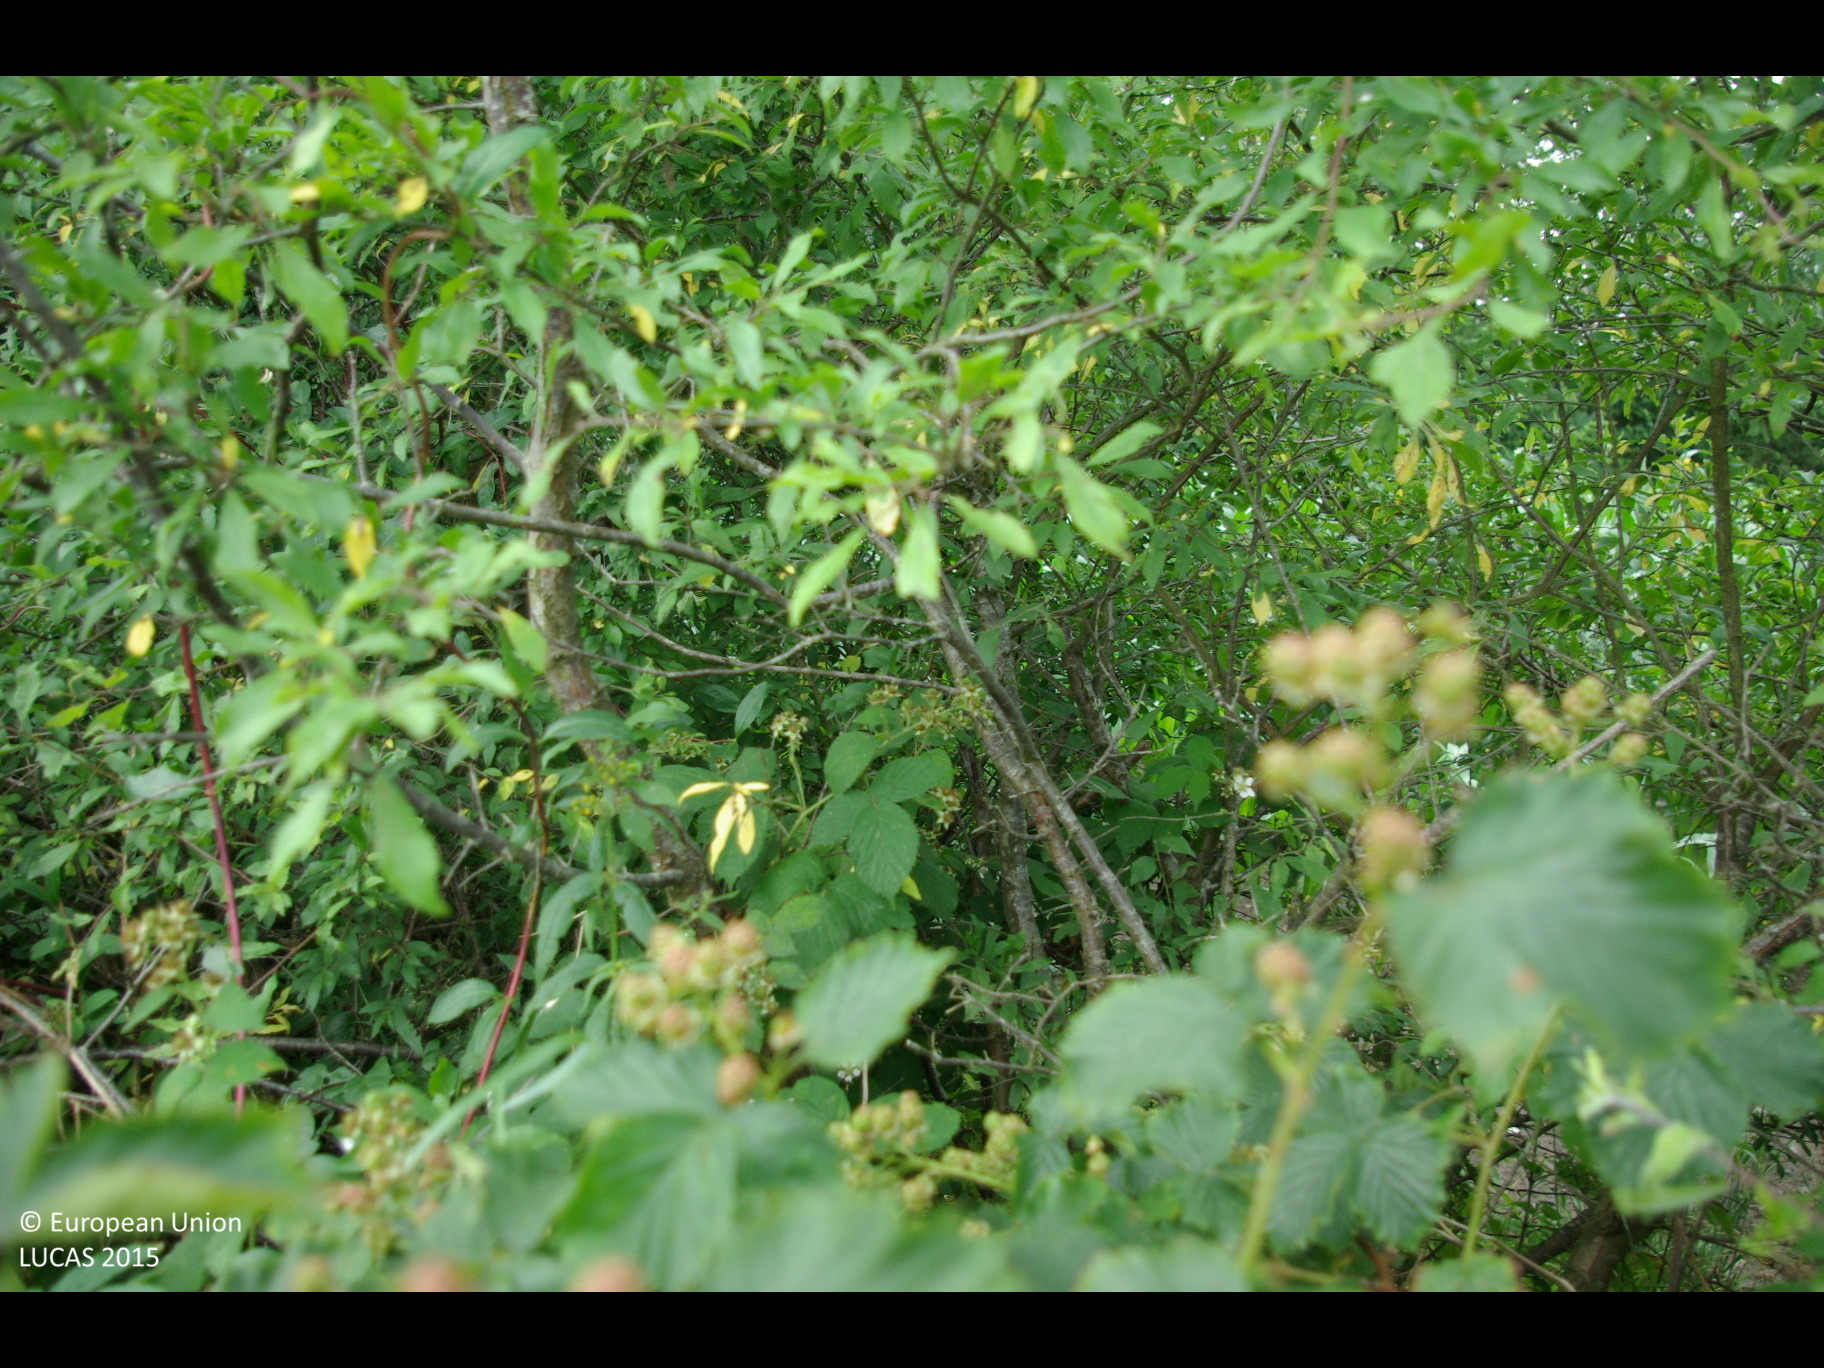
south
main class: Cropland
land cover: Maize
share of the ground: > 75 %
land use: Agriculture (excluding fallow land and kitchen gardens)
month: July
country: DE
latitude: 54.1728
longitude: 9.3111
